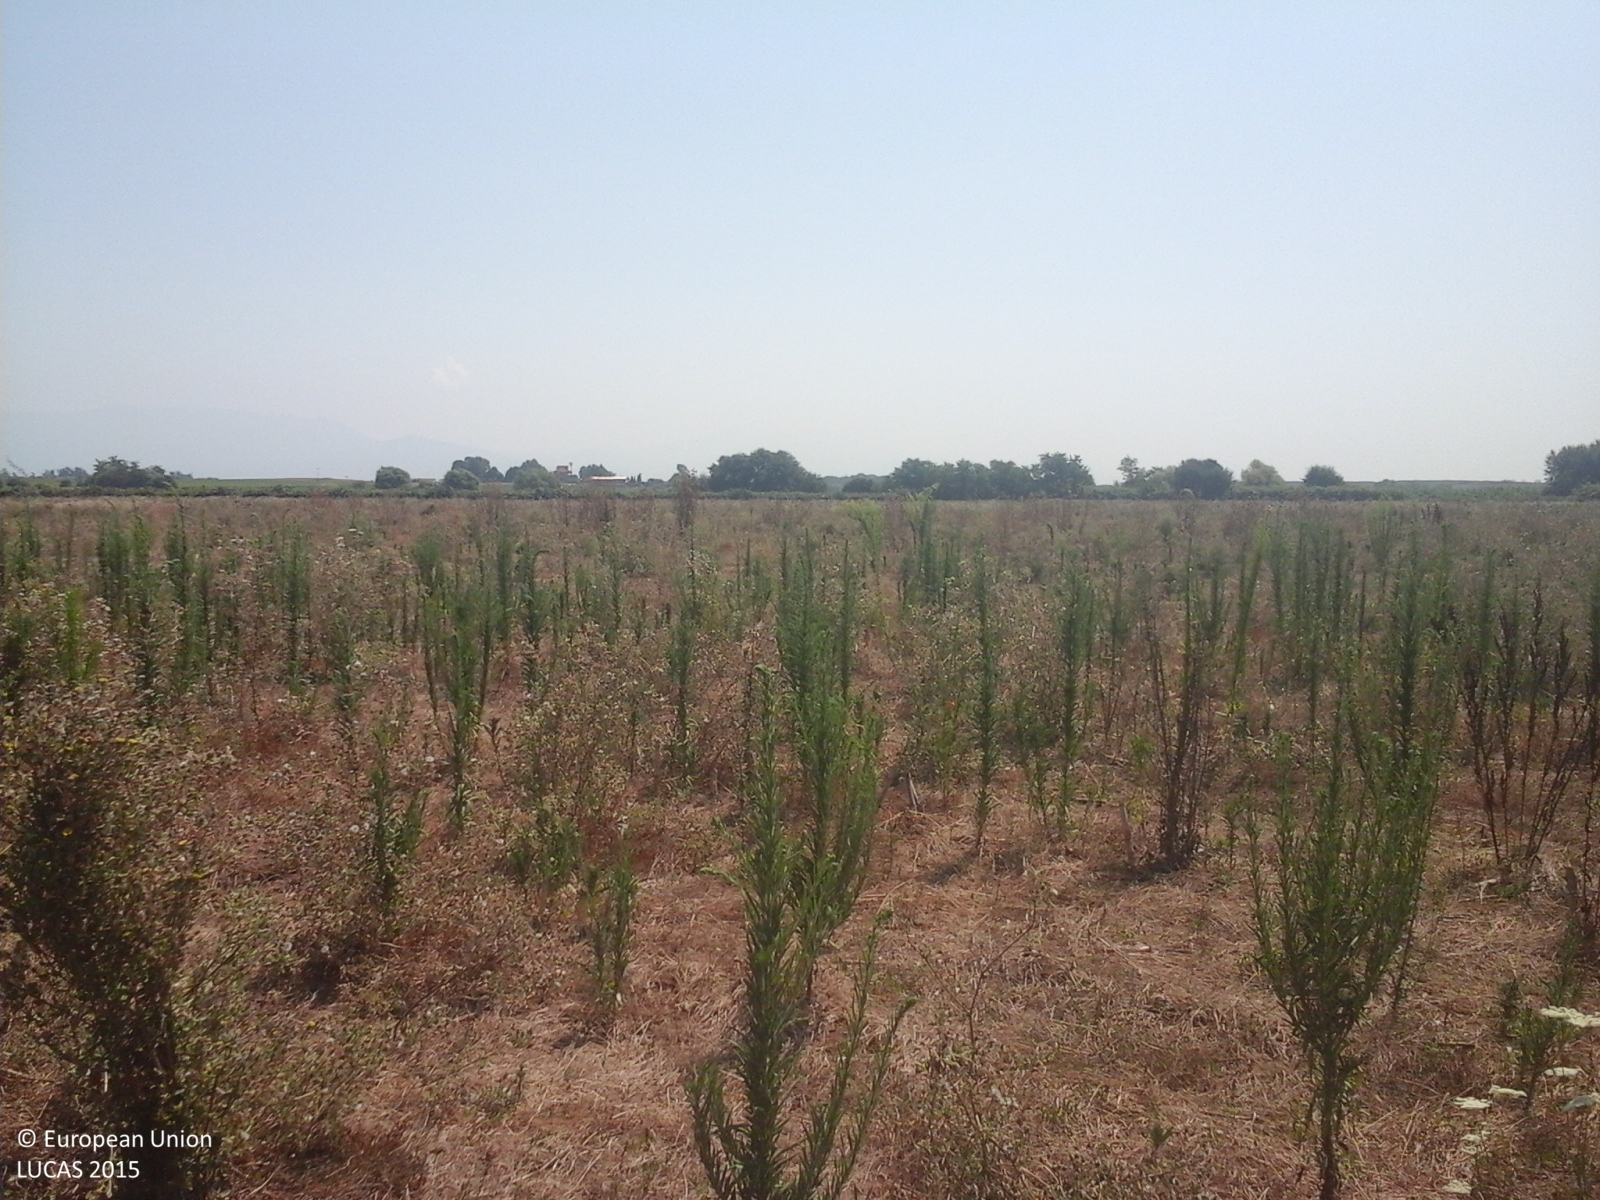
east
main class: Grassland
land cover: Grassland without tree/shrub cover
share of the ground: > 75 %
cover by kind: herbaceous plants 100 %
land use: Agriculture (excluding fallow land and kitchen gardens)
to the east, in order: Grassland without tree/shrub cover; Tracks; Ditches and canals; Grassland without tree/shrub cover
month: July
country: IT
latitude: 41.5866
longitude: 12.7362
